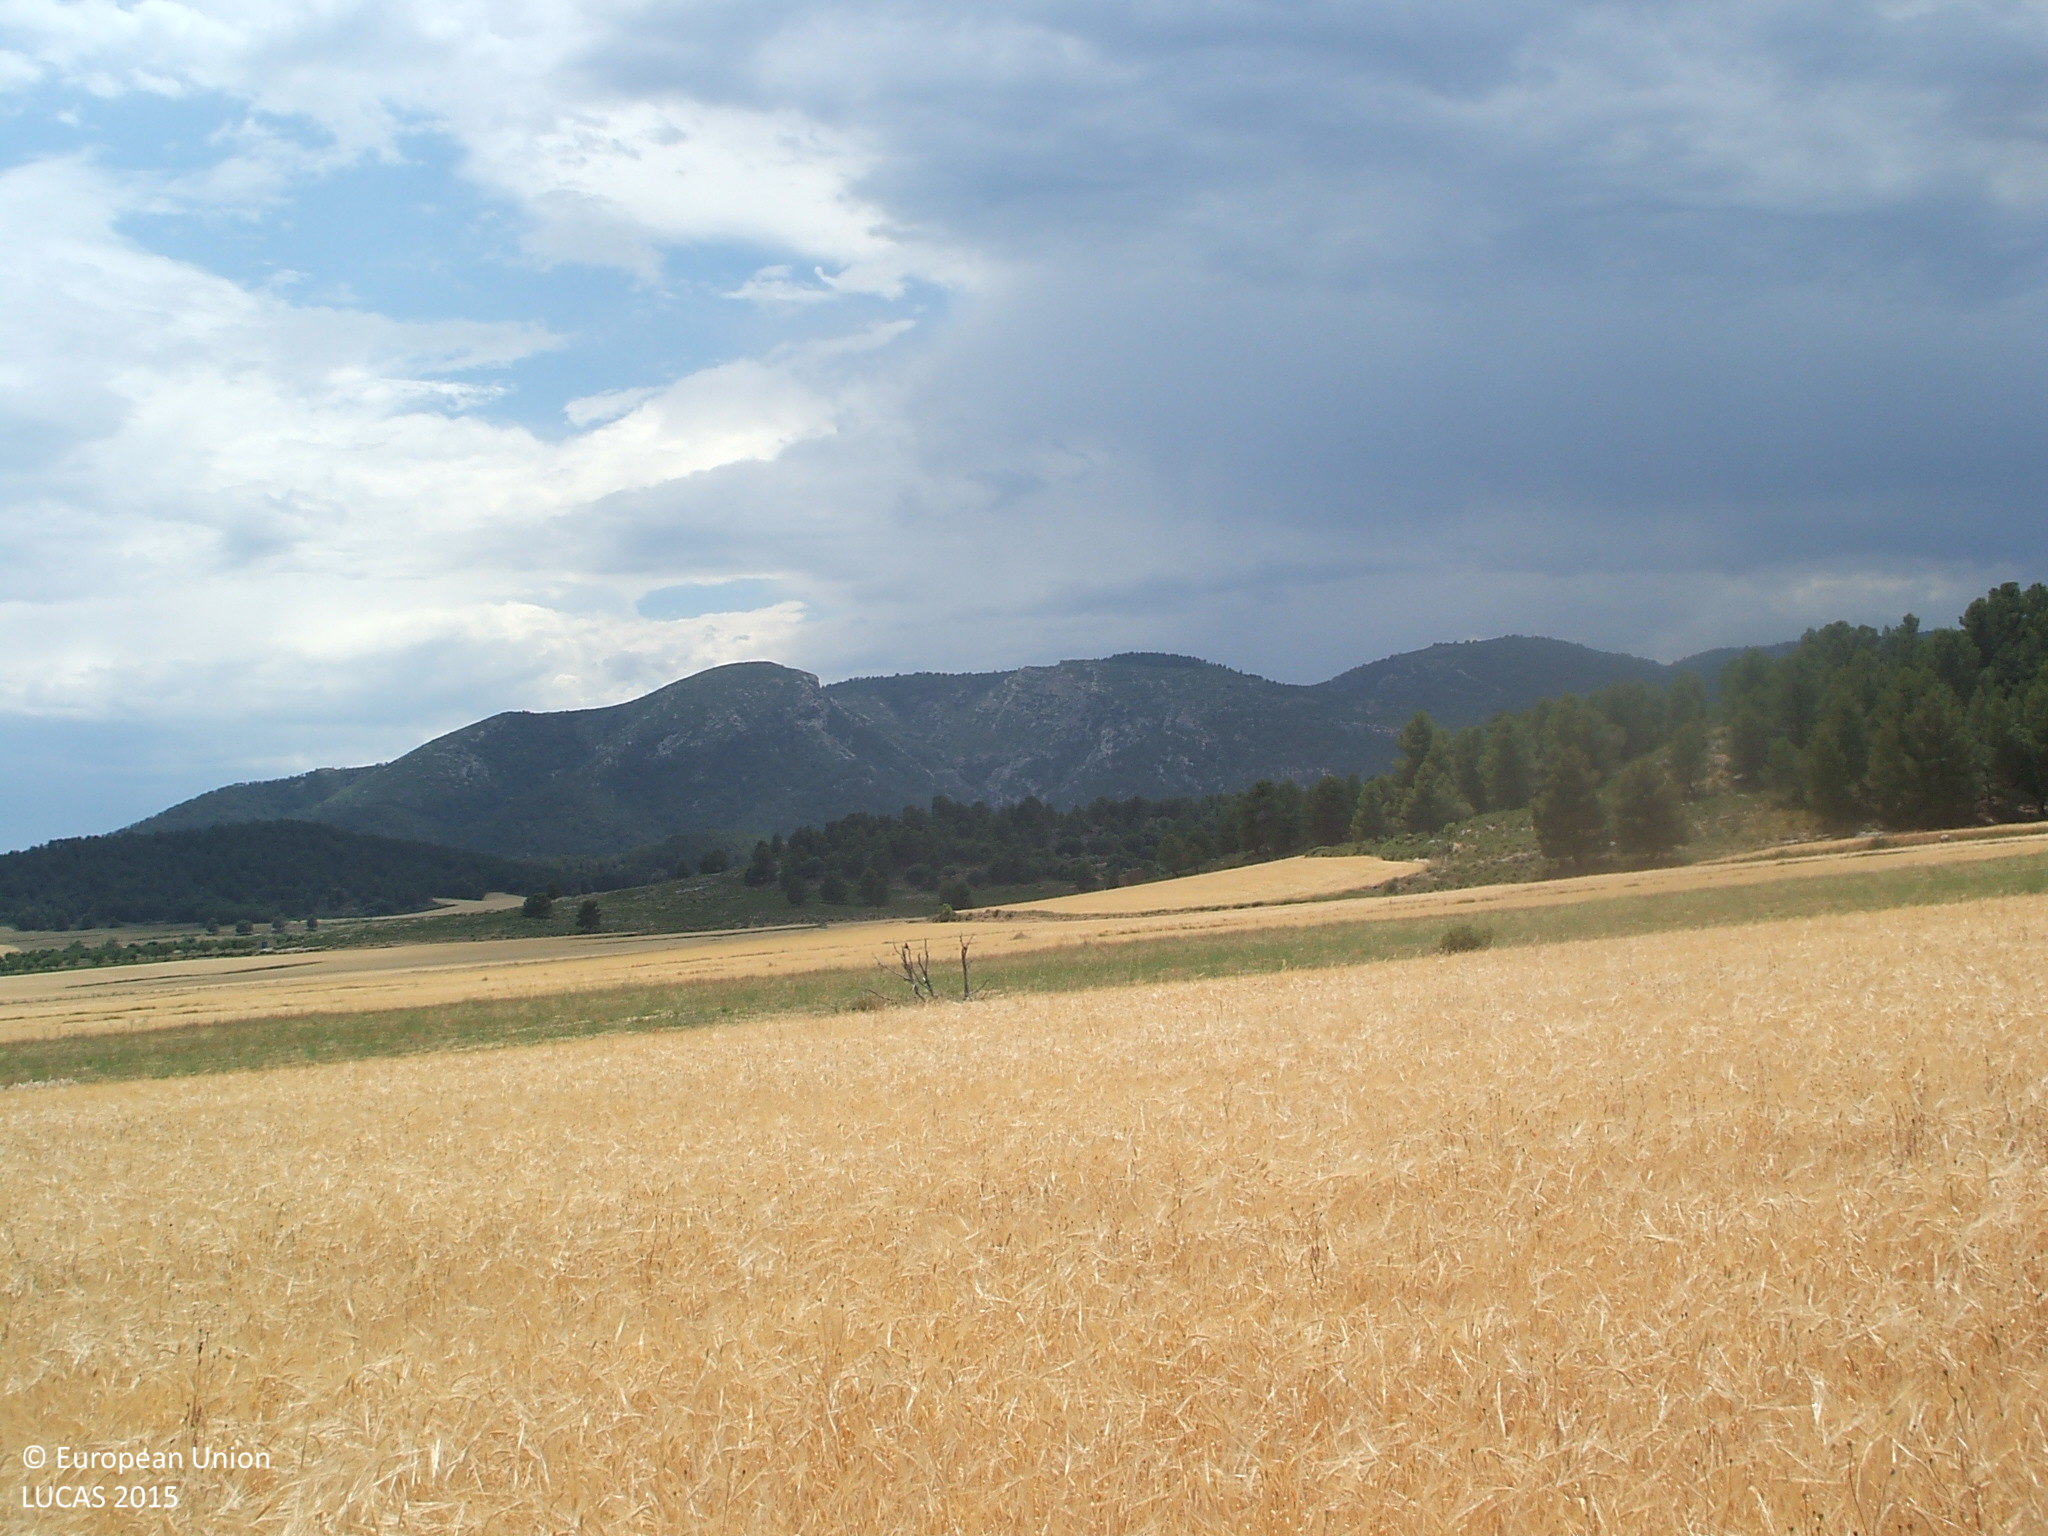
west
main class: Cropland
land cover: Barley
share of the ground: > 75 %
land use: Agriculture (excluding fallow land and kitchen gardens)
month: June
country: ES
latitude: 40.8148
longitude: -0.1457
